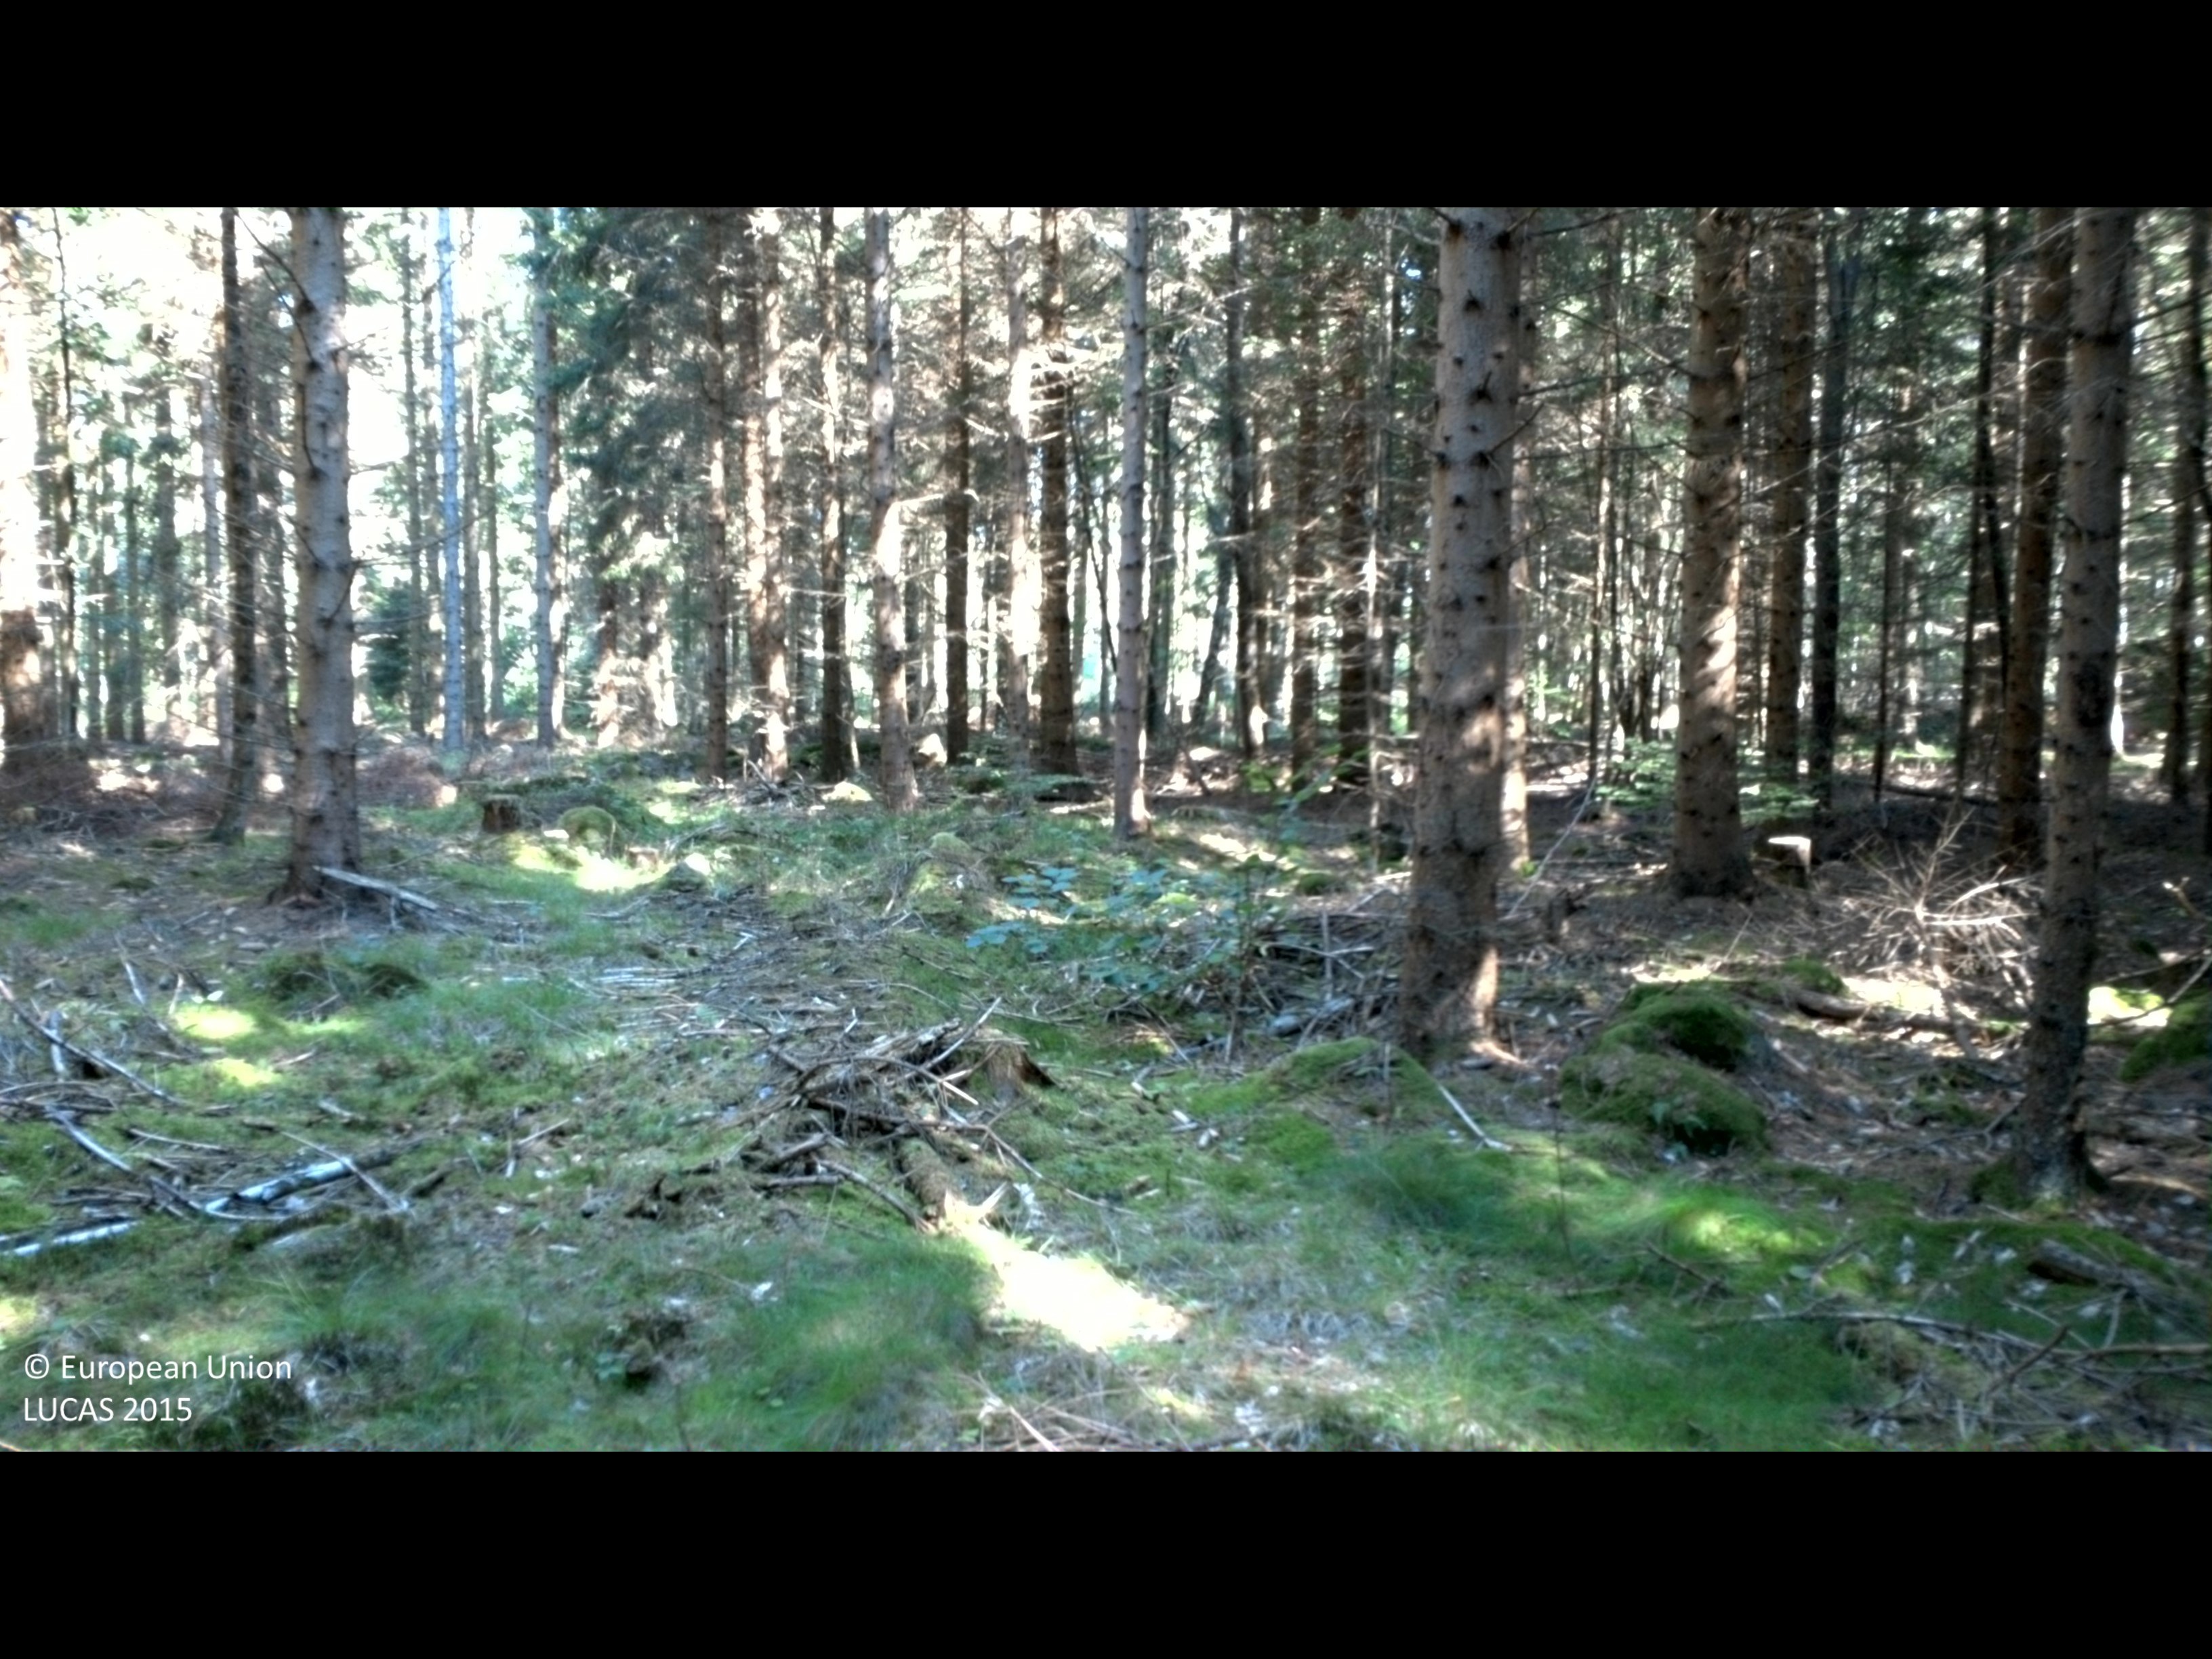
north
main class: Woodland
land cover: Spruce dominated coniferous woodland
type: boreal forest
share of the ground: > 75 %
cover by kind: coniferous forest trees 75 %, lichens and mosses 10 %, broadleaved forest trees 5 %, shrubs 5 %, herbaceous plants 5 %
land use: Forestry
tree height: > 5 m
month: August
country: SE
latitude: 56.2508
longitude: 15.8914
